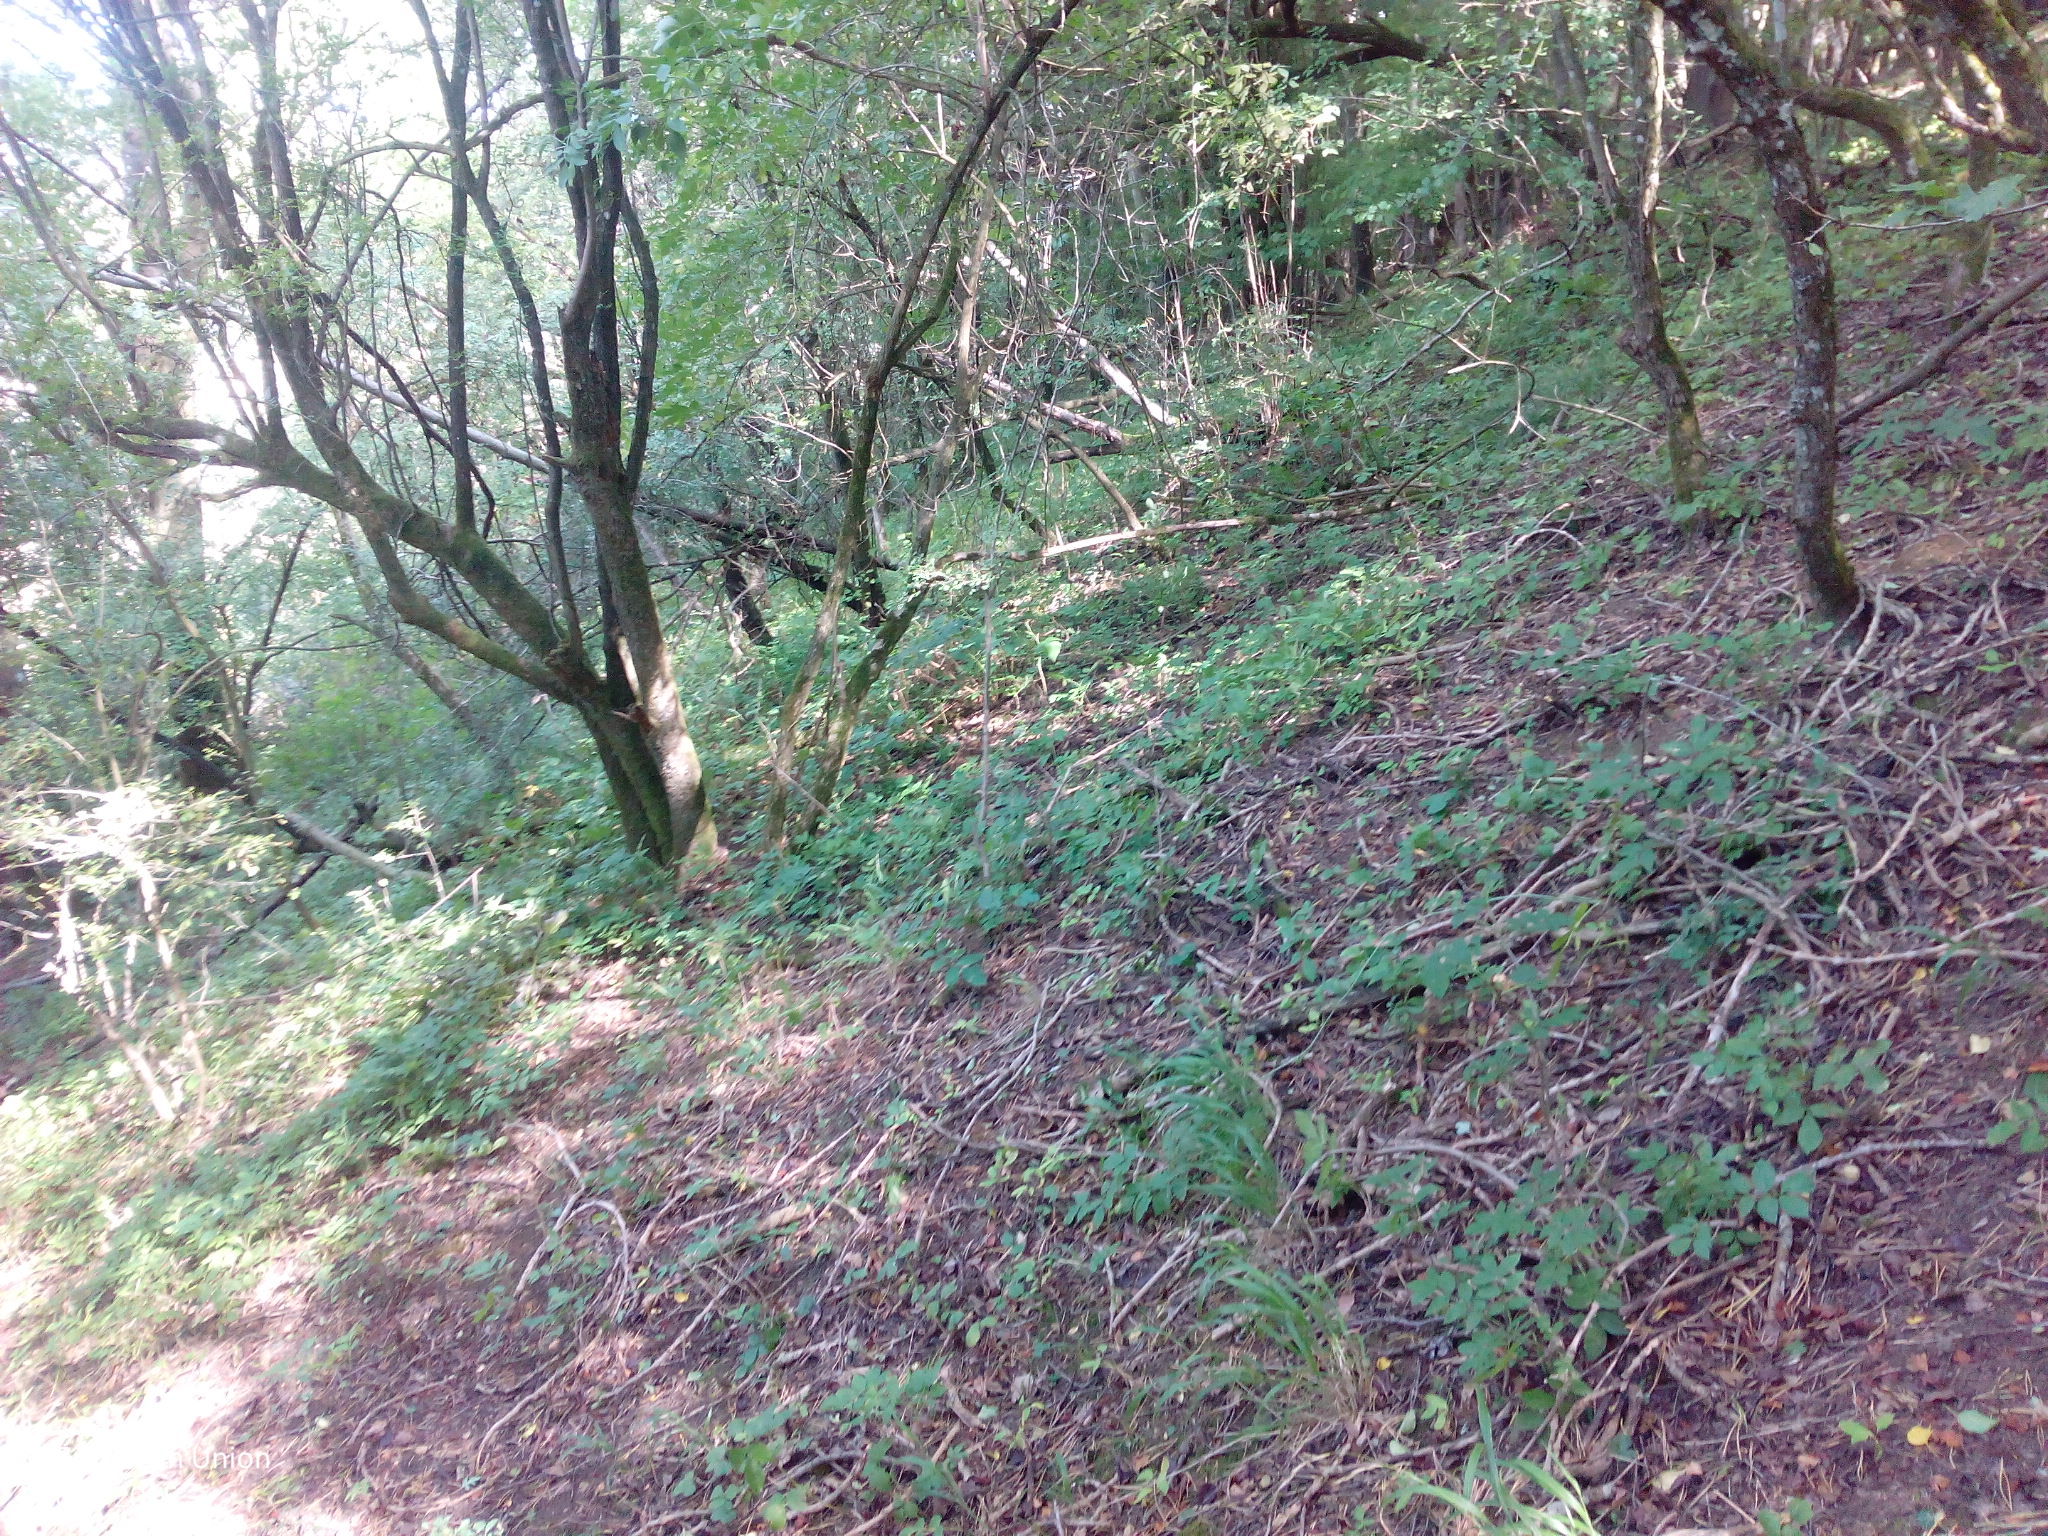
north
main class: Woodland
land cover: Broadleaved woodland
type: mesophytic deciduous forest
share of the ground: > 75 %
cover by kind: broadleaved forest trees 95 %, herbaceous plants 5 %
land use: Forestry
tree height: > 5 m
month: August
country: DE
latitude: 49.9265
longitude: 6.3081
